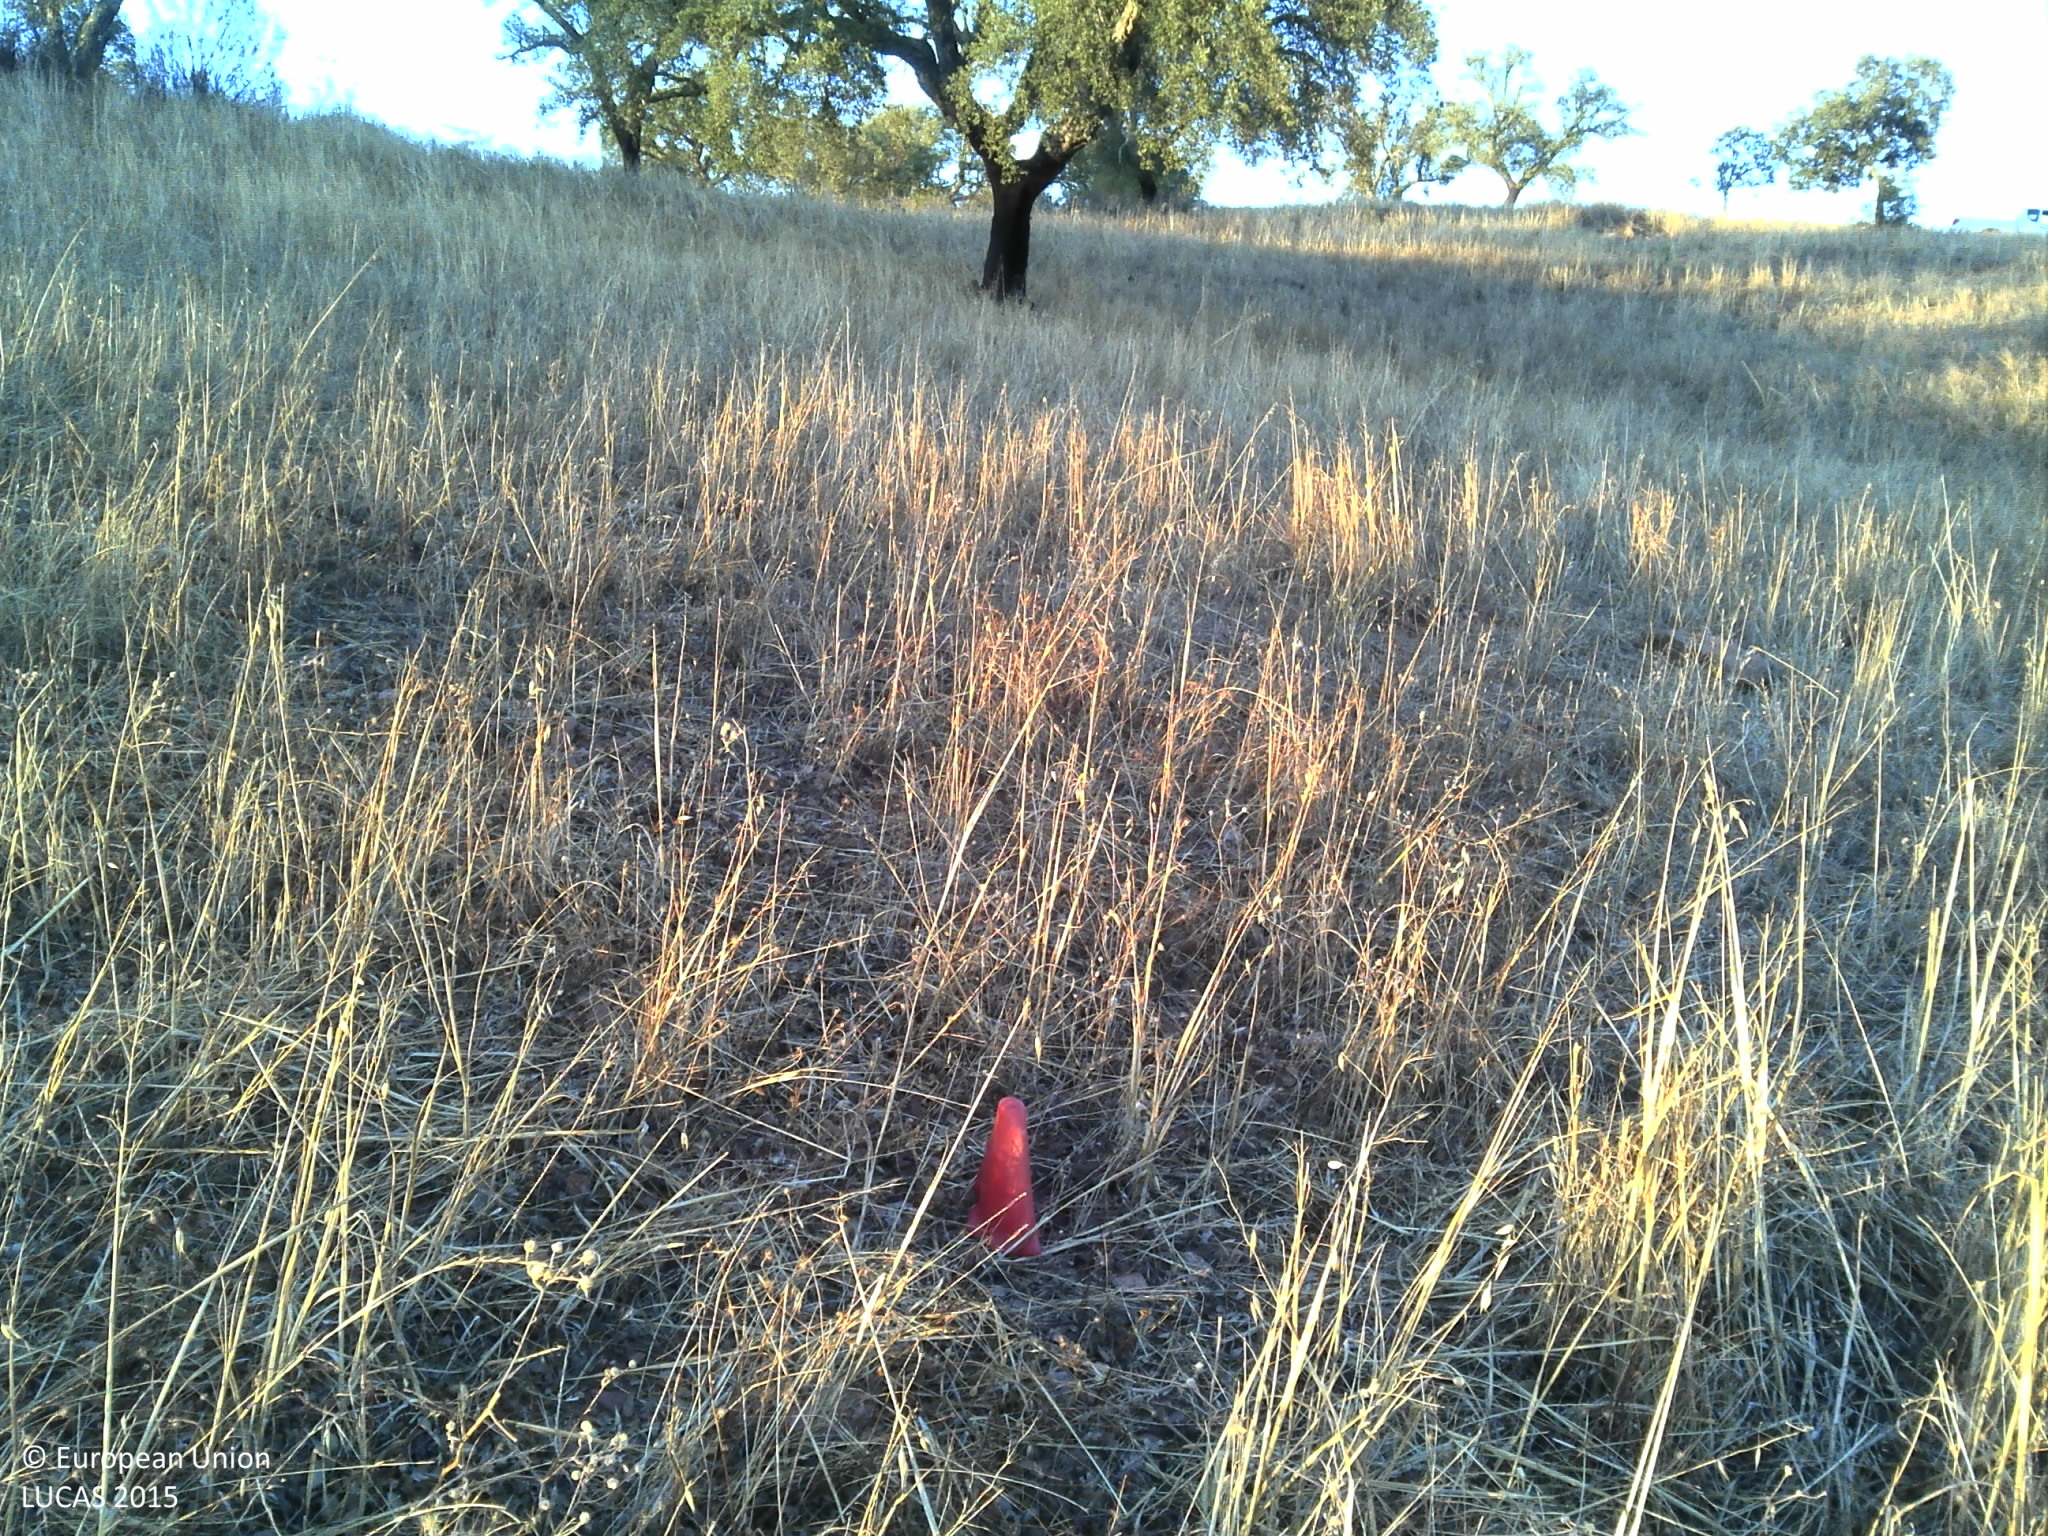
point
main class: Woodland
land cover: Broadleaved woodland
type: broadleaved evergreen forest
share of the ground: 10 - 25 %
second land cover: Spontaneously vegetated surfaces
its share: 50 - 75 %
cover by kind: herbaceous plants 50 %, broadleaved forest trees 25 %, unconsolidated bare surface 25 %
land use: Forestry
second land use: Agriculture (excluding fallow land and kitchen gardens)
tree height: > 5 m
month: June
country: PT
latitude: 37.8851
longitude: -7.3068
